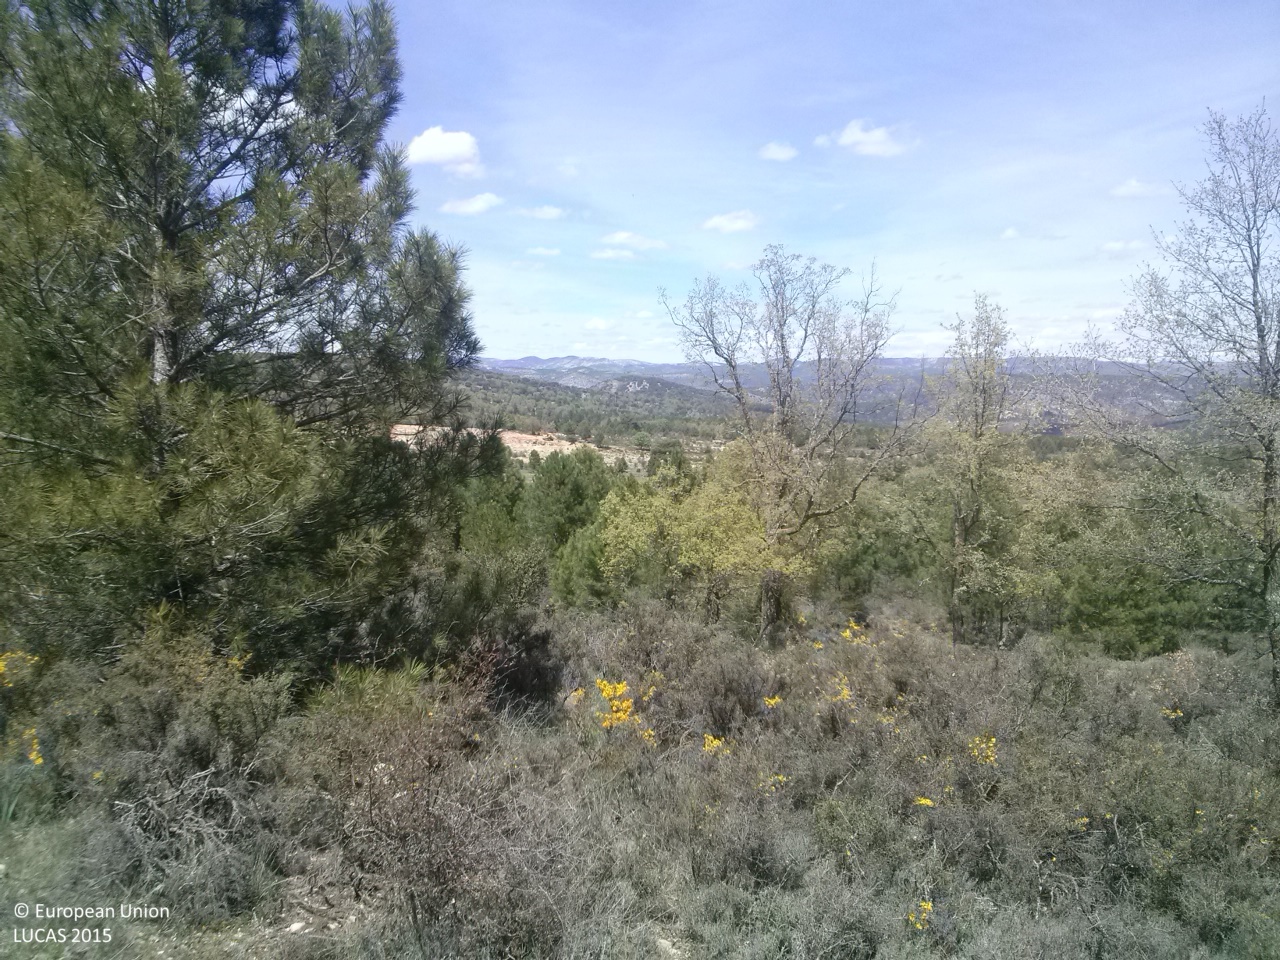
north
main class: Woodland
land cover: Other mixed woodland
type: thermophilous deciduous forest
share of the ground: 10 - 25 %
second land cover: Shrubland without tree cover
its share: 50 - 75 %
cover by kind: shrubs 40 %, herbaceous plants 35 %, broadleaved forest trees 15 %, coniferous forest trees 5 %, unconsolidated bare surface 5 %
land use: Forestry
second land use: Agriculture (excluding fallow land and kitchen gardens)
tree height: > 5 m
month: April
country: ES
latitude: 40.0125
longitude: -1.6208
